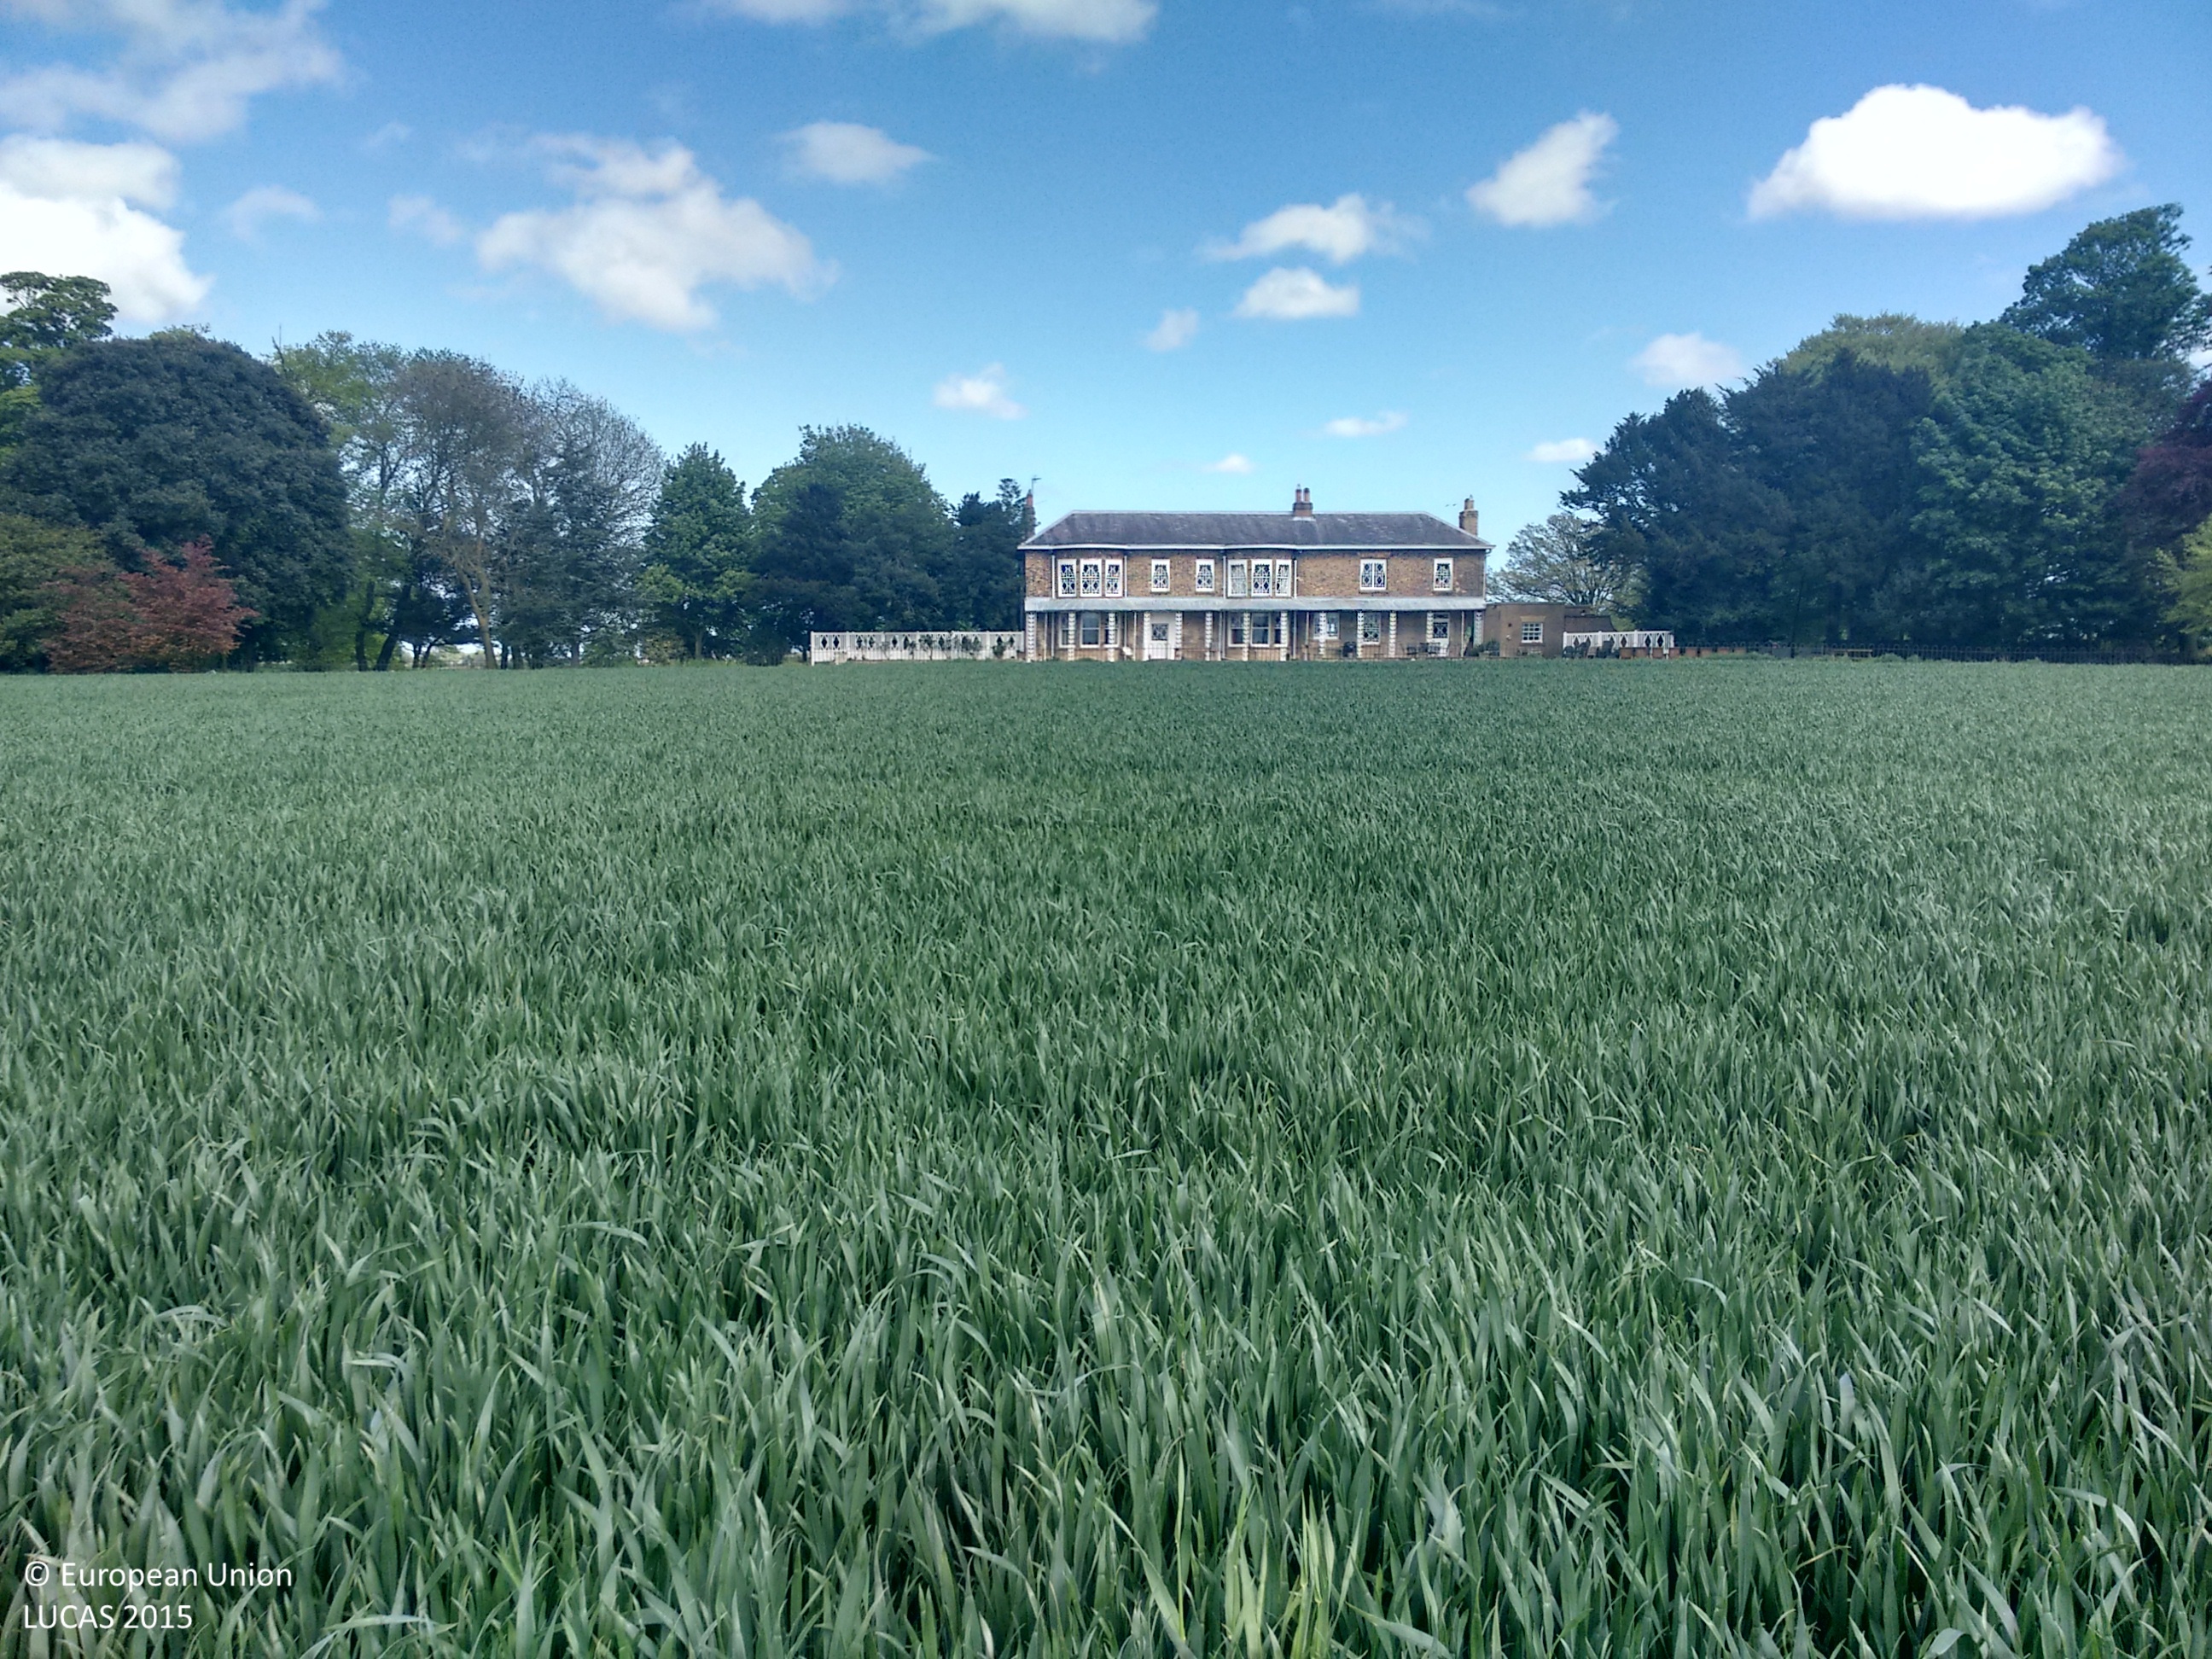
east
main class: Cropland
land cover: Common wheat
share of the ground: > 75 %
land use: Agriculture (excluding fallow land and kitchen gardens)
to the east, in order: Common wheat; Artificial constructions in urban areas; Grassland without tree/shrub cover; Single bushes/trees; Grassland without tree/shrub cover
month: May
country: GB
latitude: 53.8326
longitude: -0.2908
